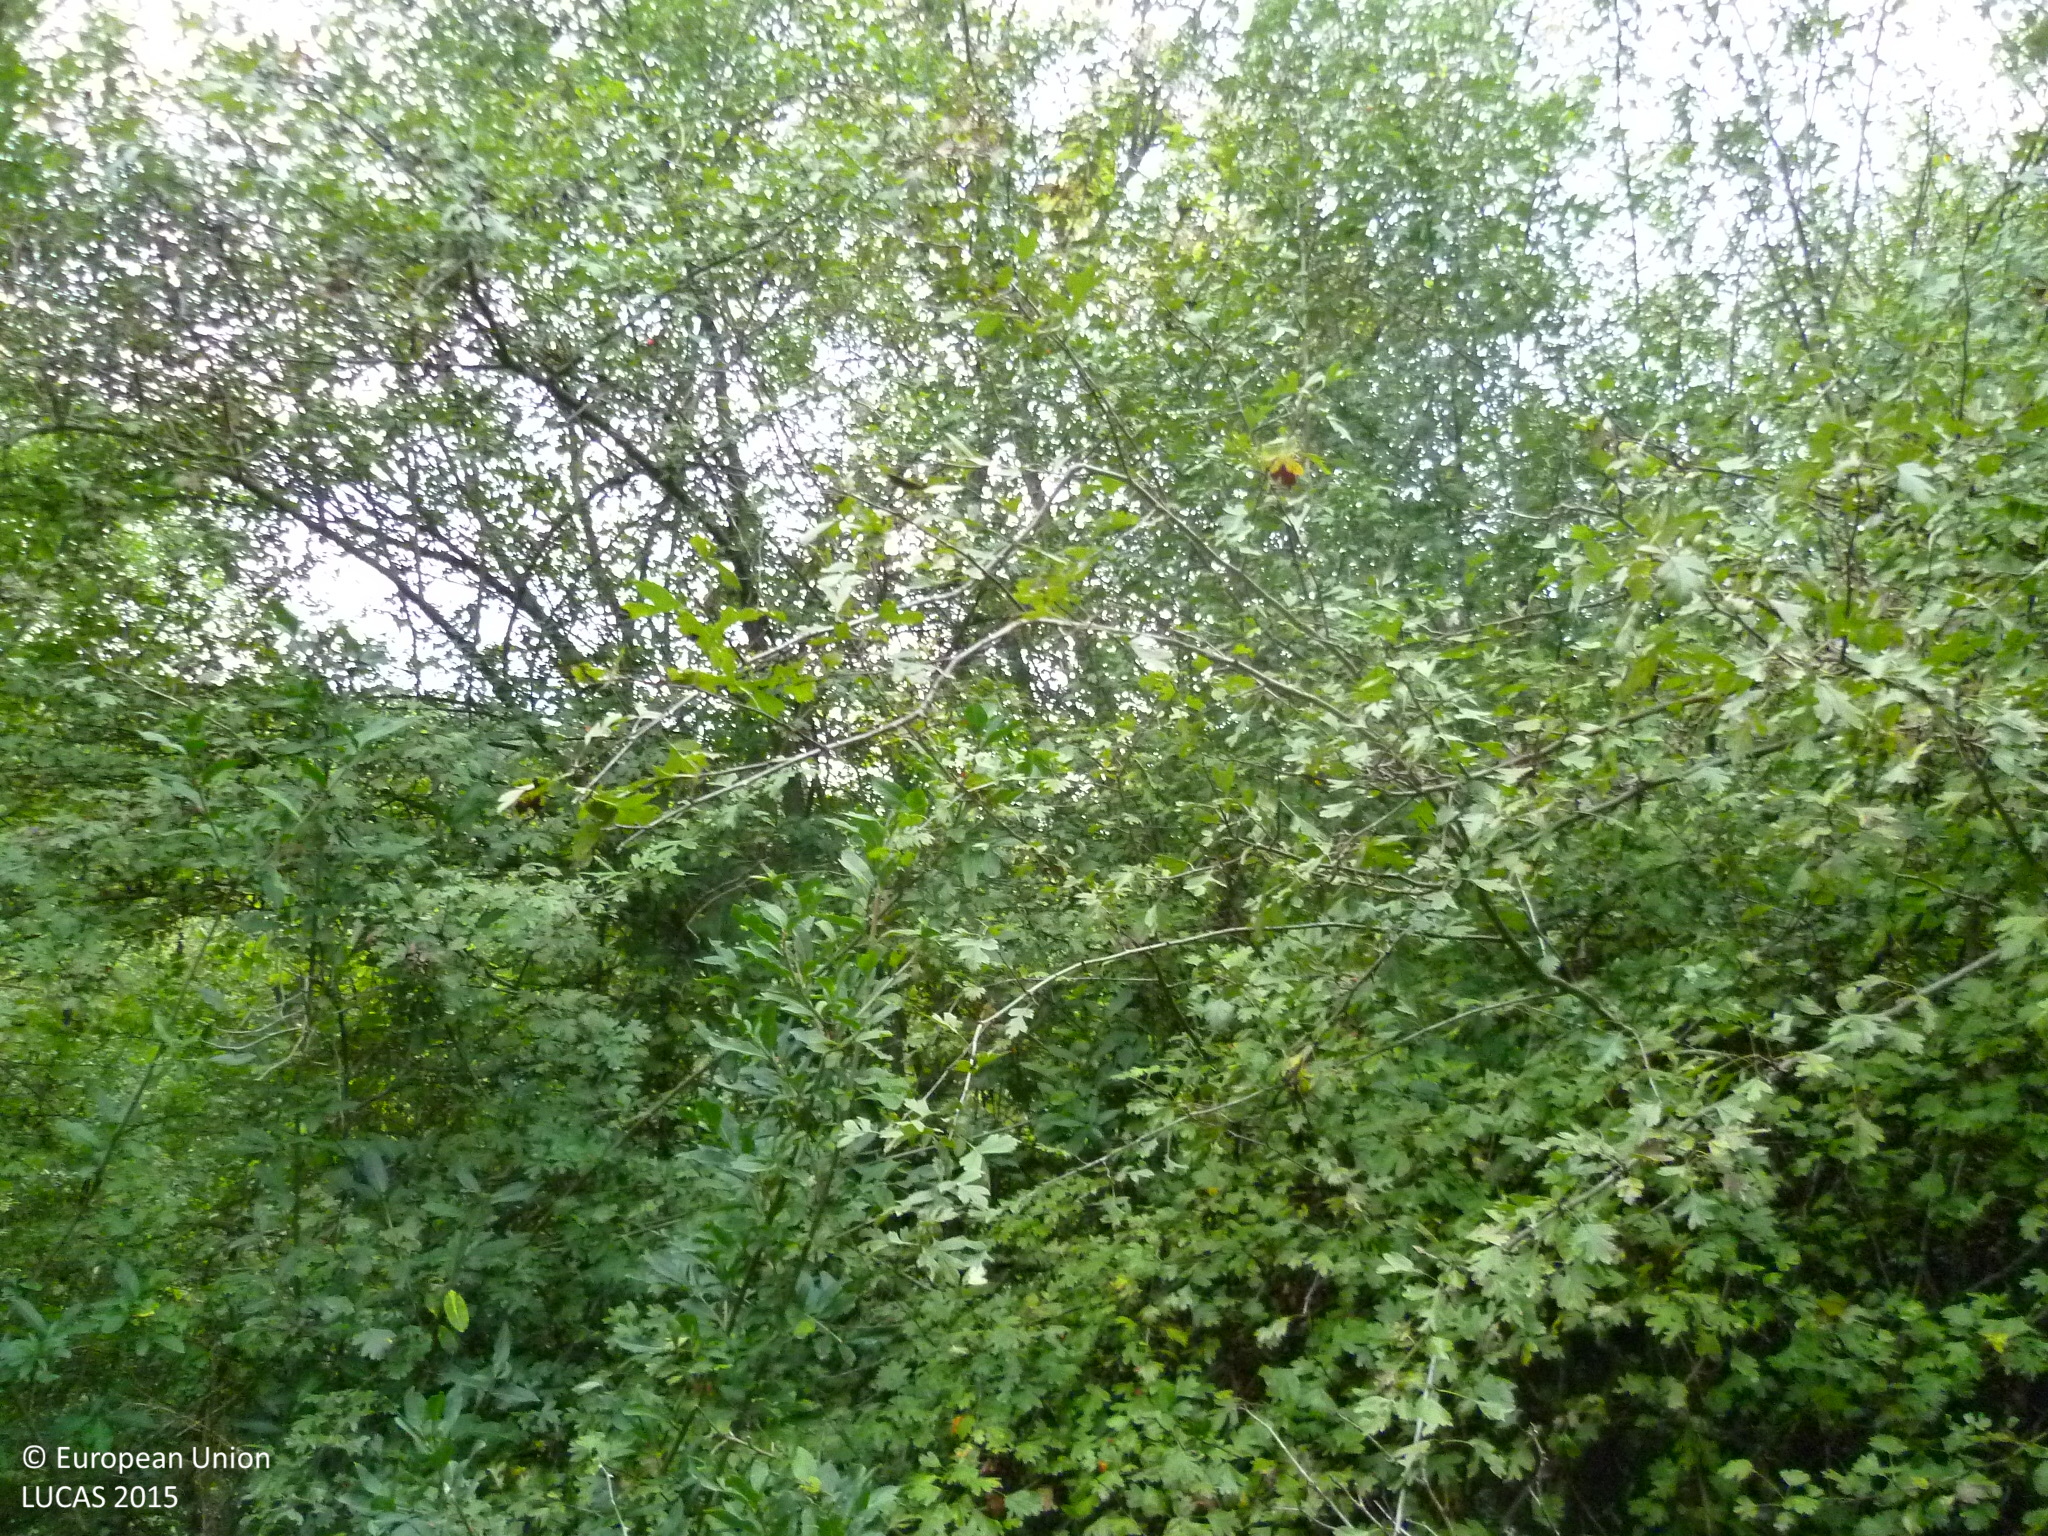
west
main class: Shrubland
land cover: Shrubland with sparse tree cover
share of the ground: > 75 %
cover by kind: shrubs 90 %, broadleaved forest trees 5 %, herbaceous plants 5 %
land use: Semi-natural and natural areas not in use
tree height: < 5 m
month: September
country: BG
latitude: 42.7488
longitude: 22.8191
